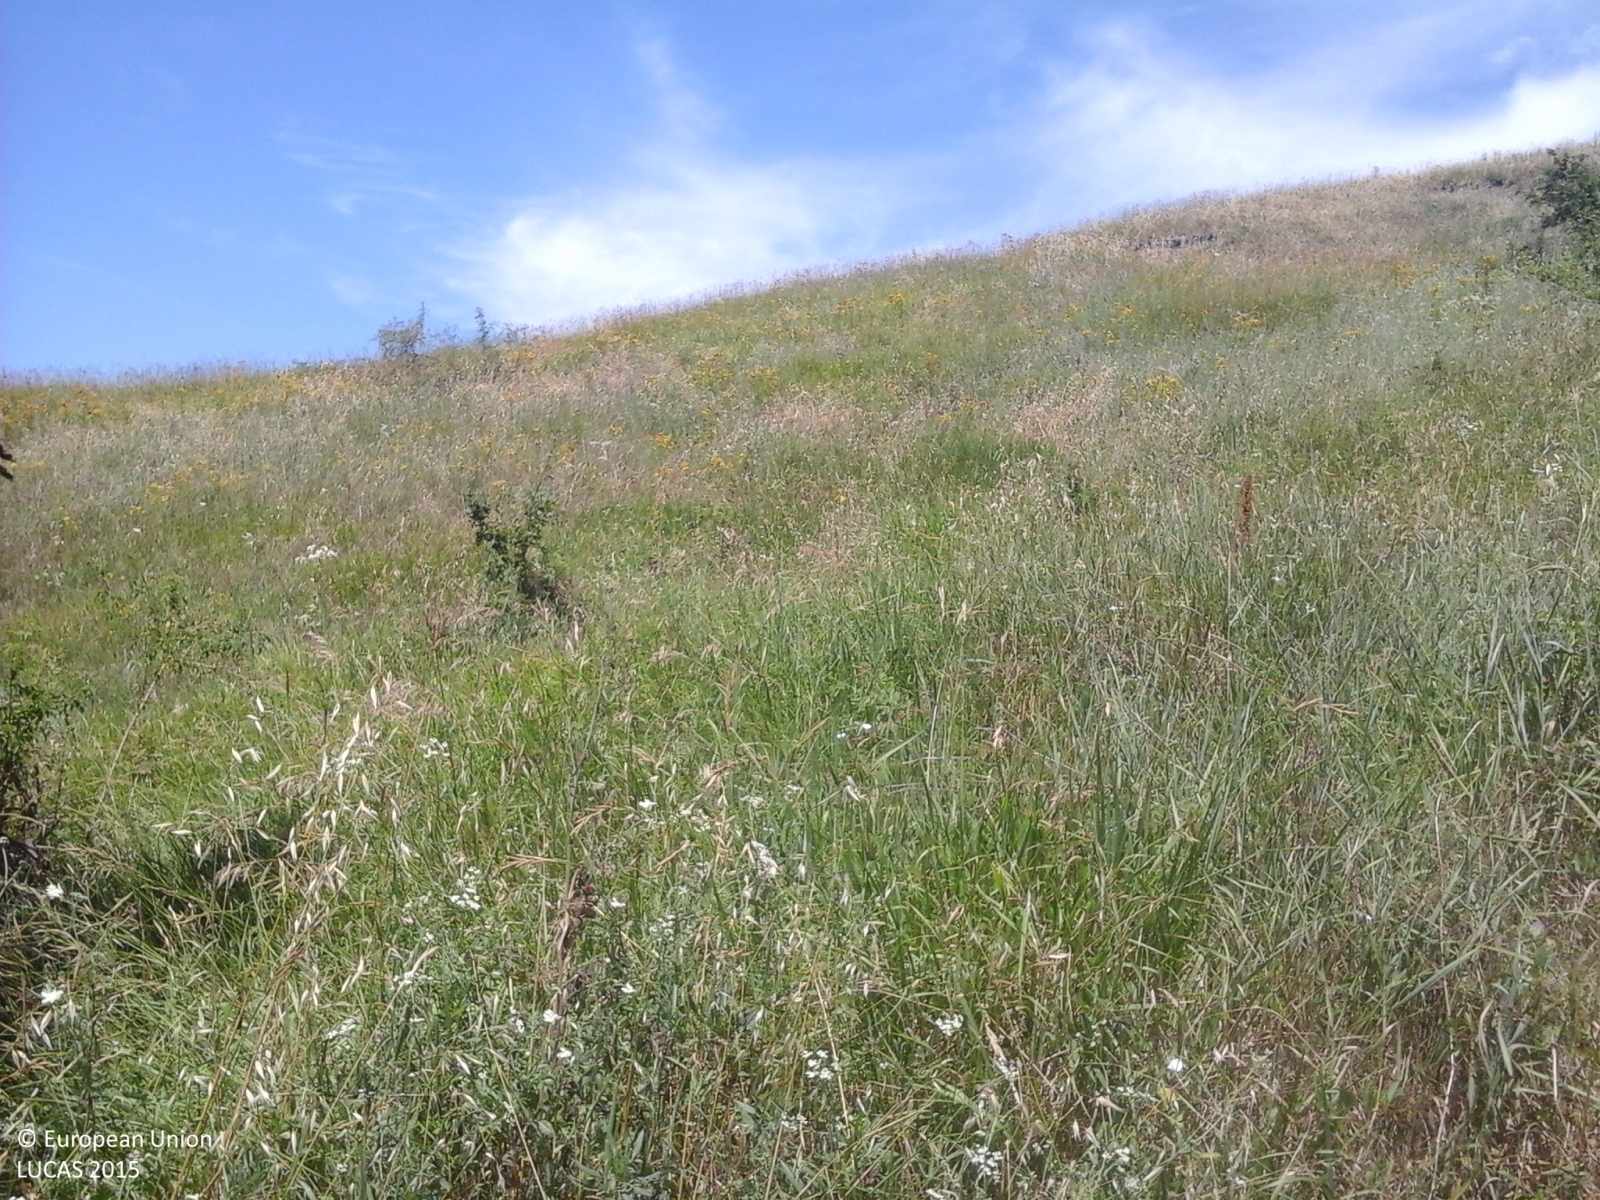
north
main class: Grassland
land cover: Grassland with sparse tree/shrub cover
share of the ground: > 75 %
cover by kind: herbaceous plants 90 %, broadleaved forest trees 5 %, shrubs 5 %
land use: Semi-natural and natural areas not in use
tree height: > 5 m
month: June
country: IT
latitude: 44.4929
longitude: 10.6399
